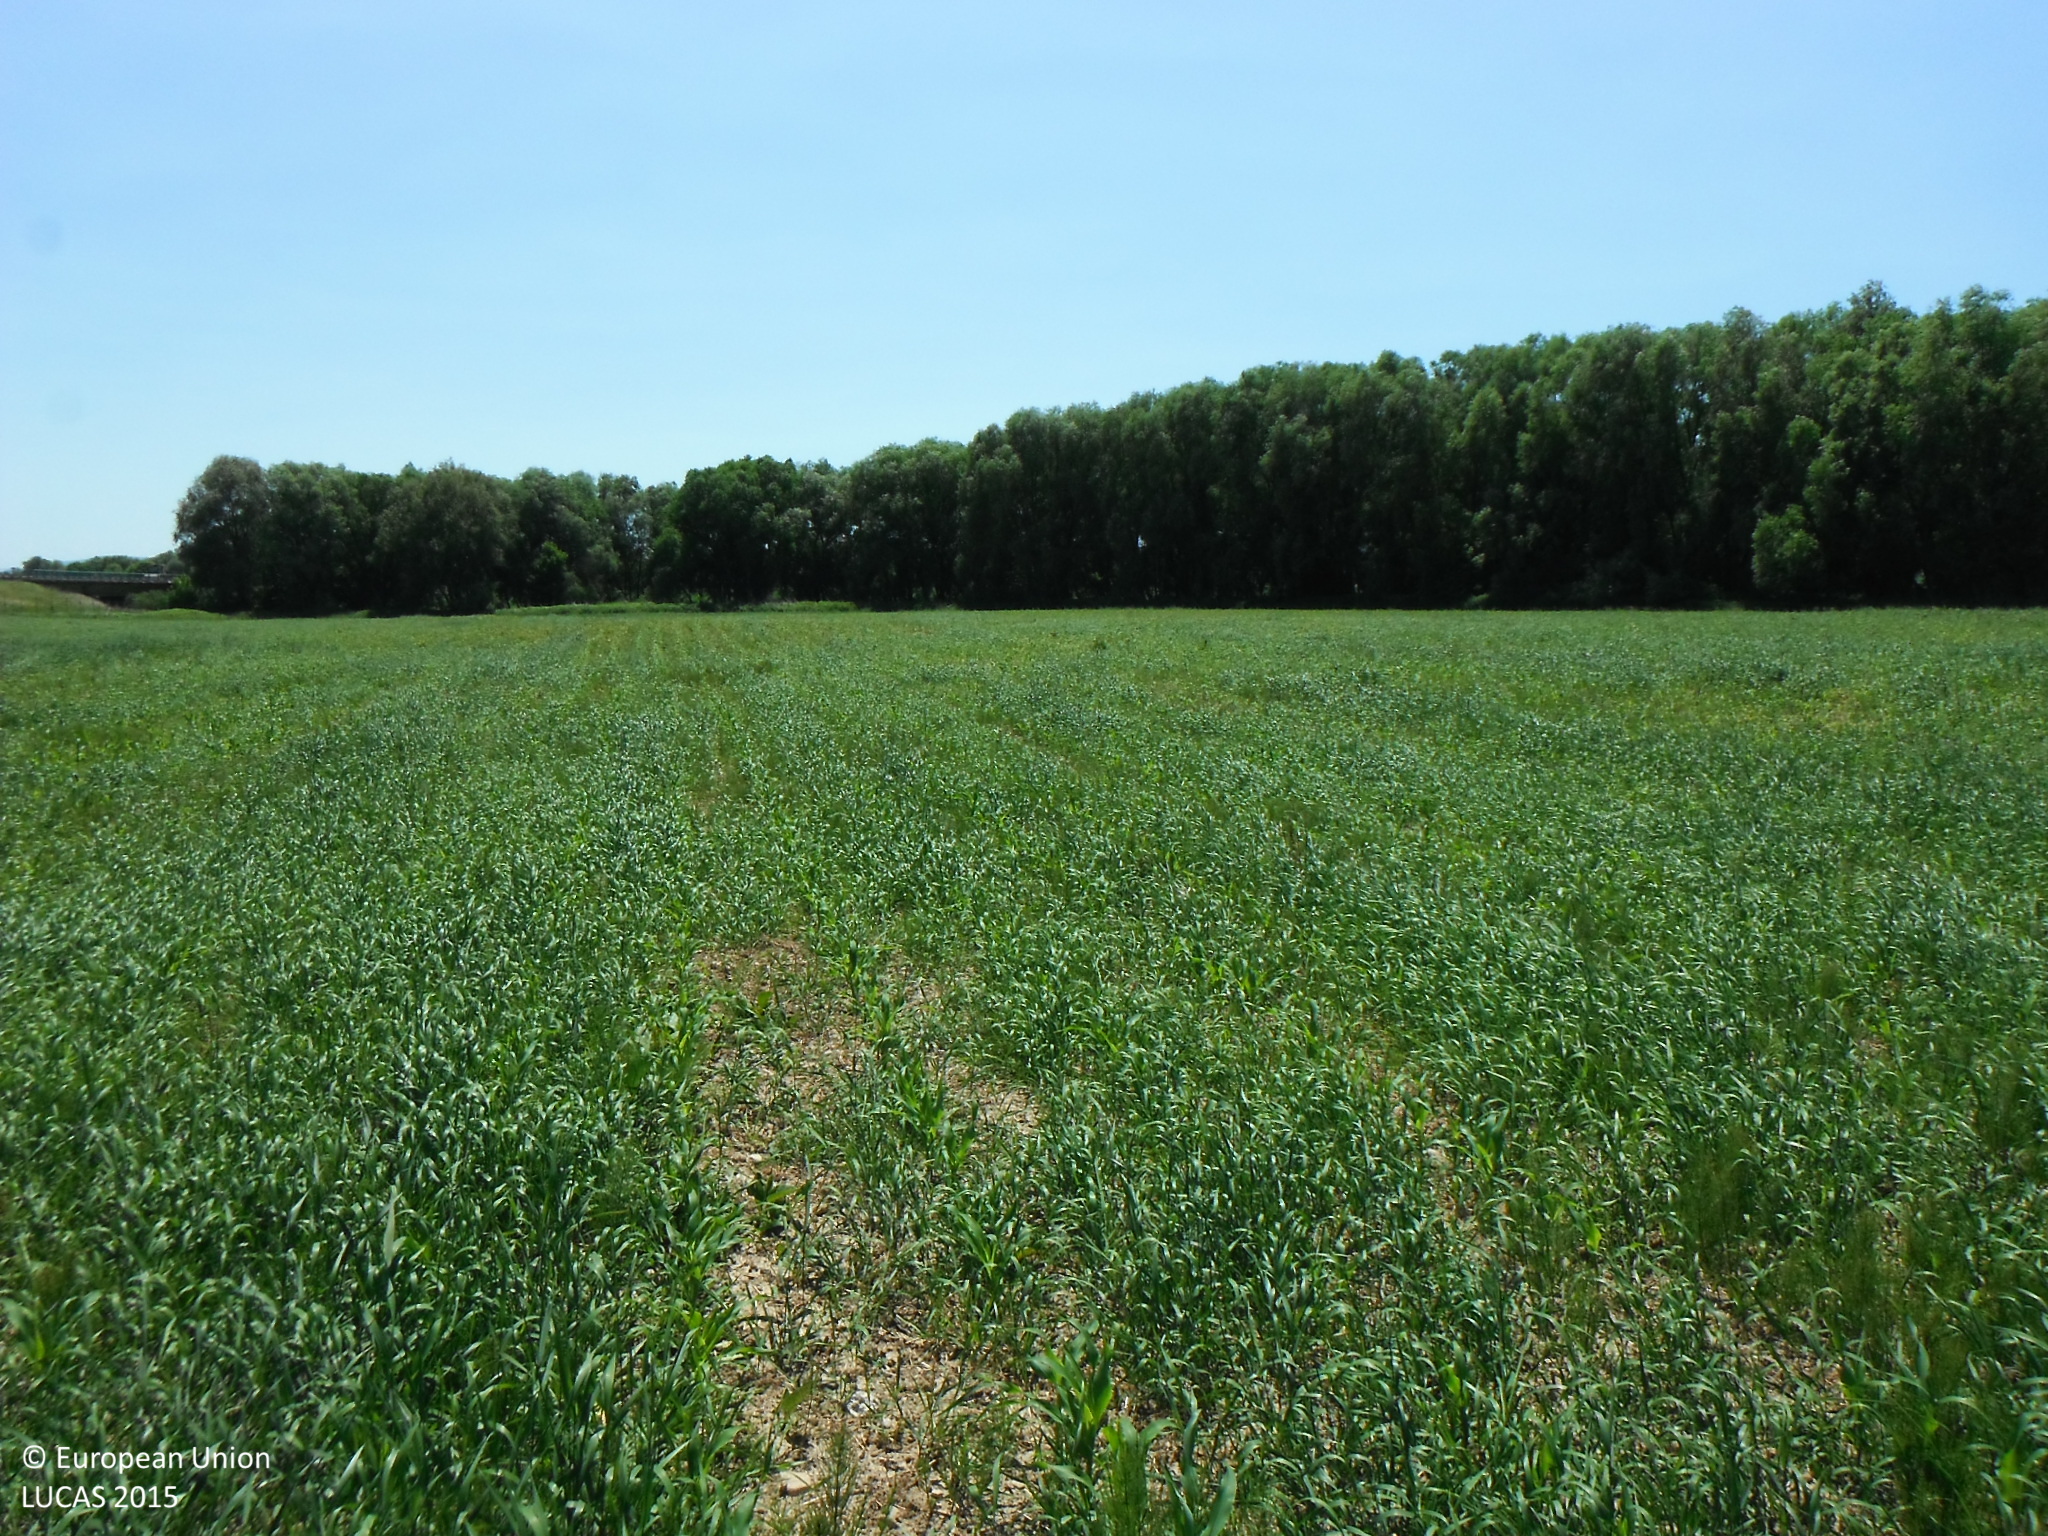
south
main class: Cropland
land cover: Maize
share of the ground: 10 - 25 %
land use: Agriculture (excluding fallow land and kitchen gardens)
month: June
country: SK
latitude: 48.8204
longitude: 21.3090
